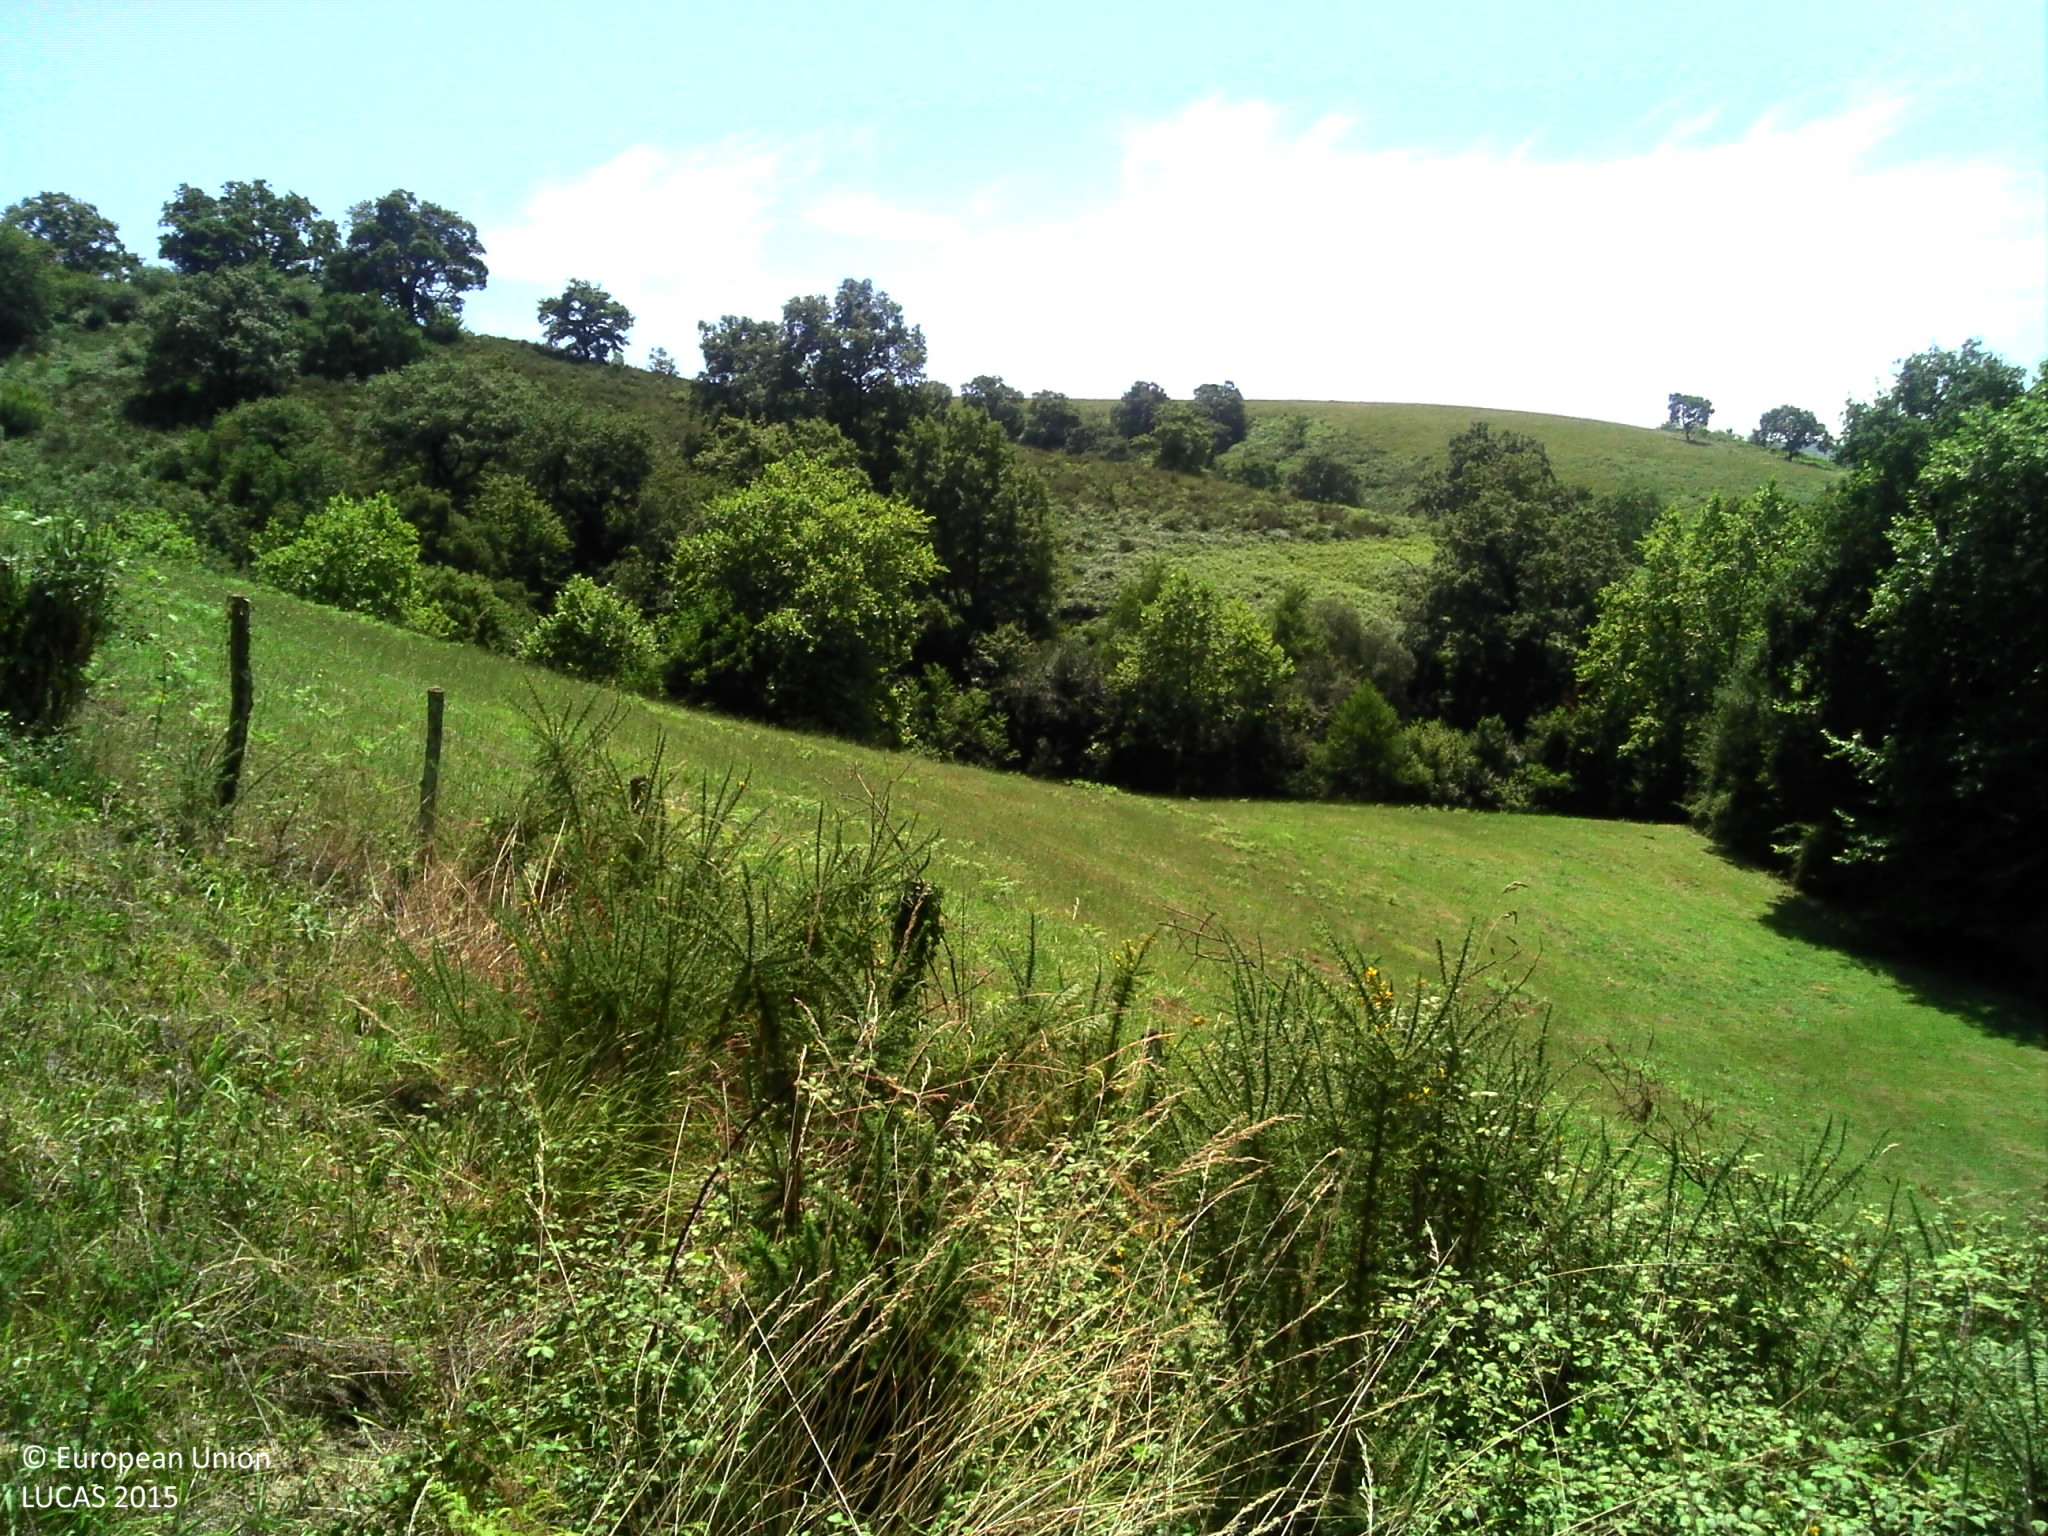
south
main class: Grassland
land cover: Grassland without tree/shrub cover
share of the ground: > 75 %
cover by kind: herbaceous plants 95 %, shrubs 5 %
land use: Agriculture (excluding fallow land and kitchen gardens)
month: August
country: FR
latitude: 43.3318
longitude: -1.1259
